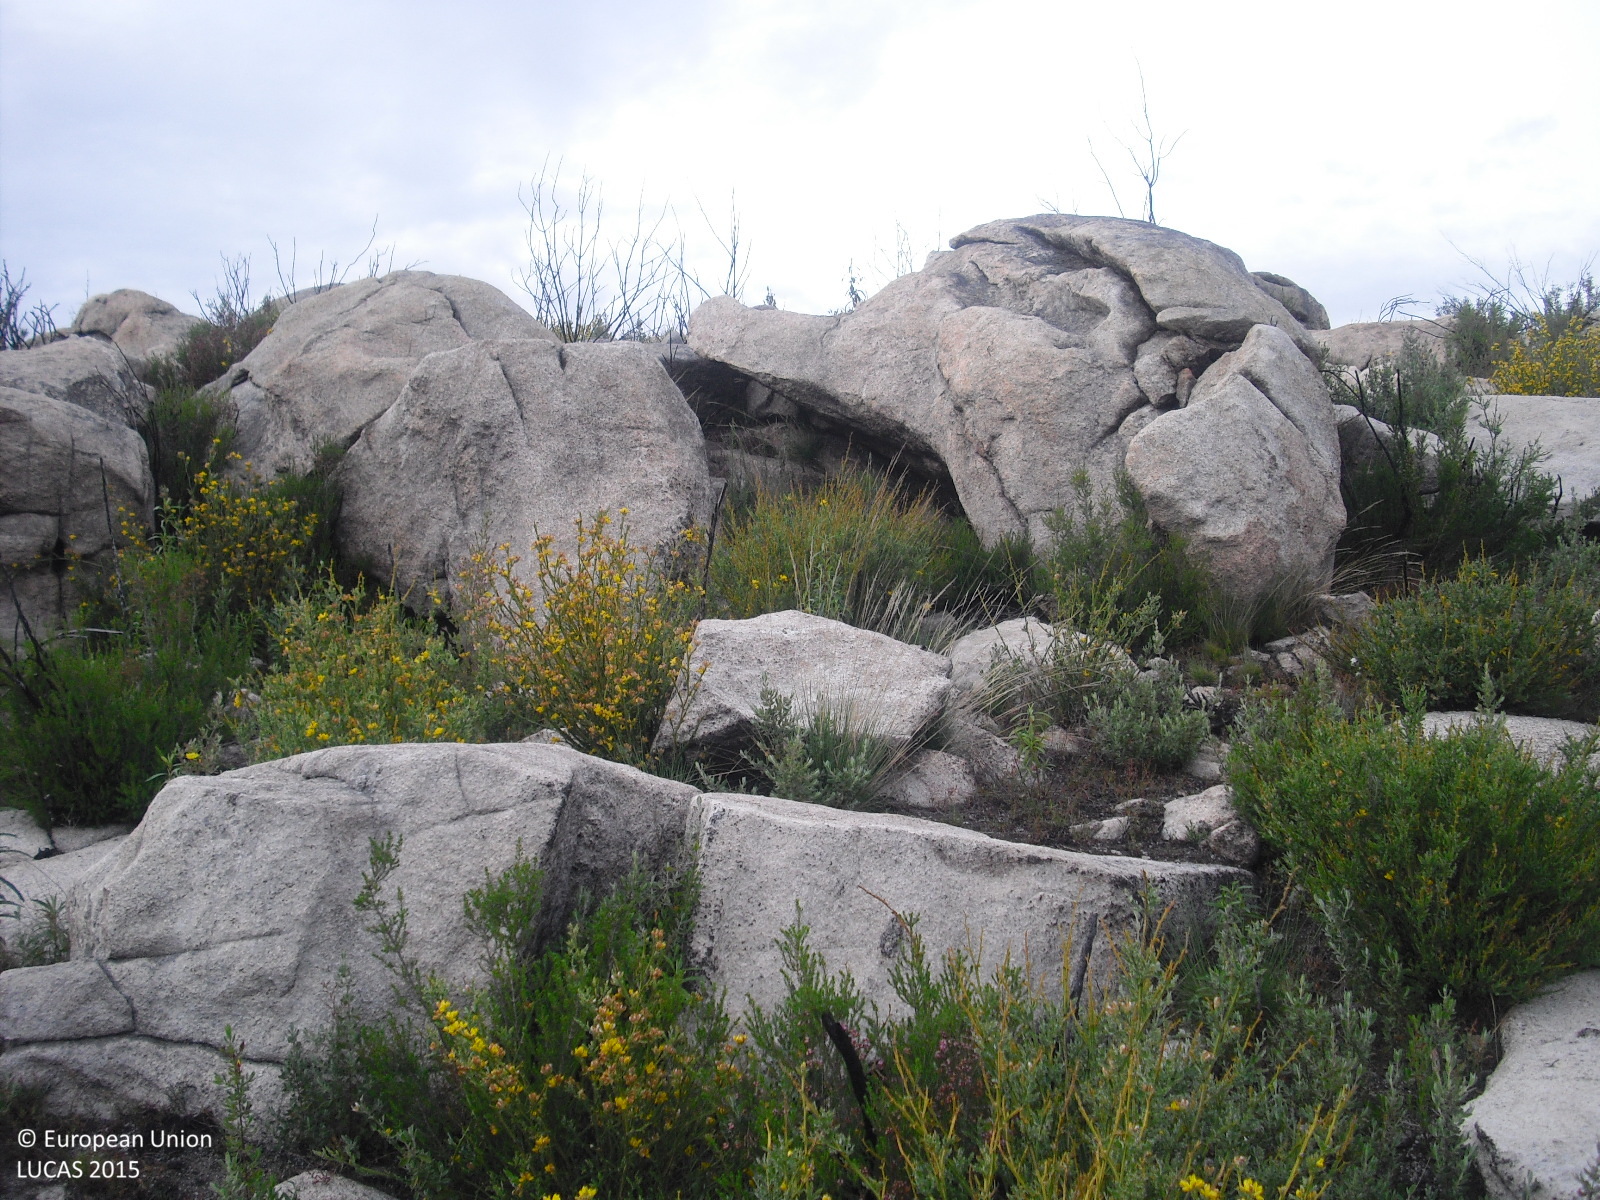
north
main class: Shrubland
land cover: Shrubland without tree cover
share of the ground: 50 - 75 %
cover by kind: shrubs 50 %, consolidated bare surface 20 %, unconsolidated bare surface 20 %, herbaceous plants 10 %
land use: Semi-natural and natural areas not in use
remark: Burnt area
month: April
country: ES
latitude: 41.8873
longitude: -7.6233
